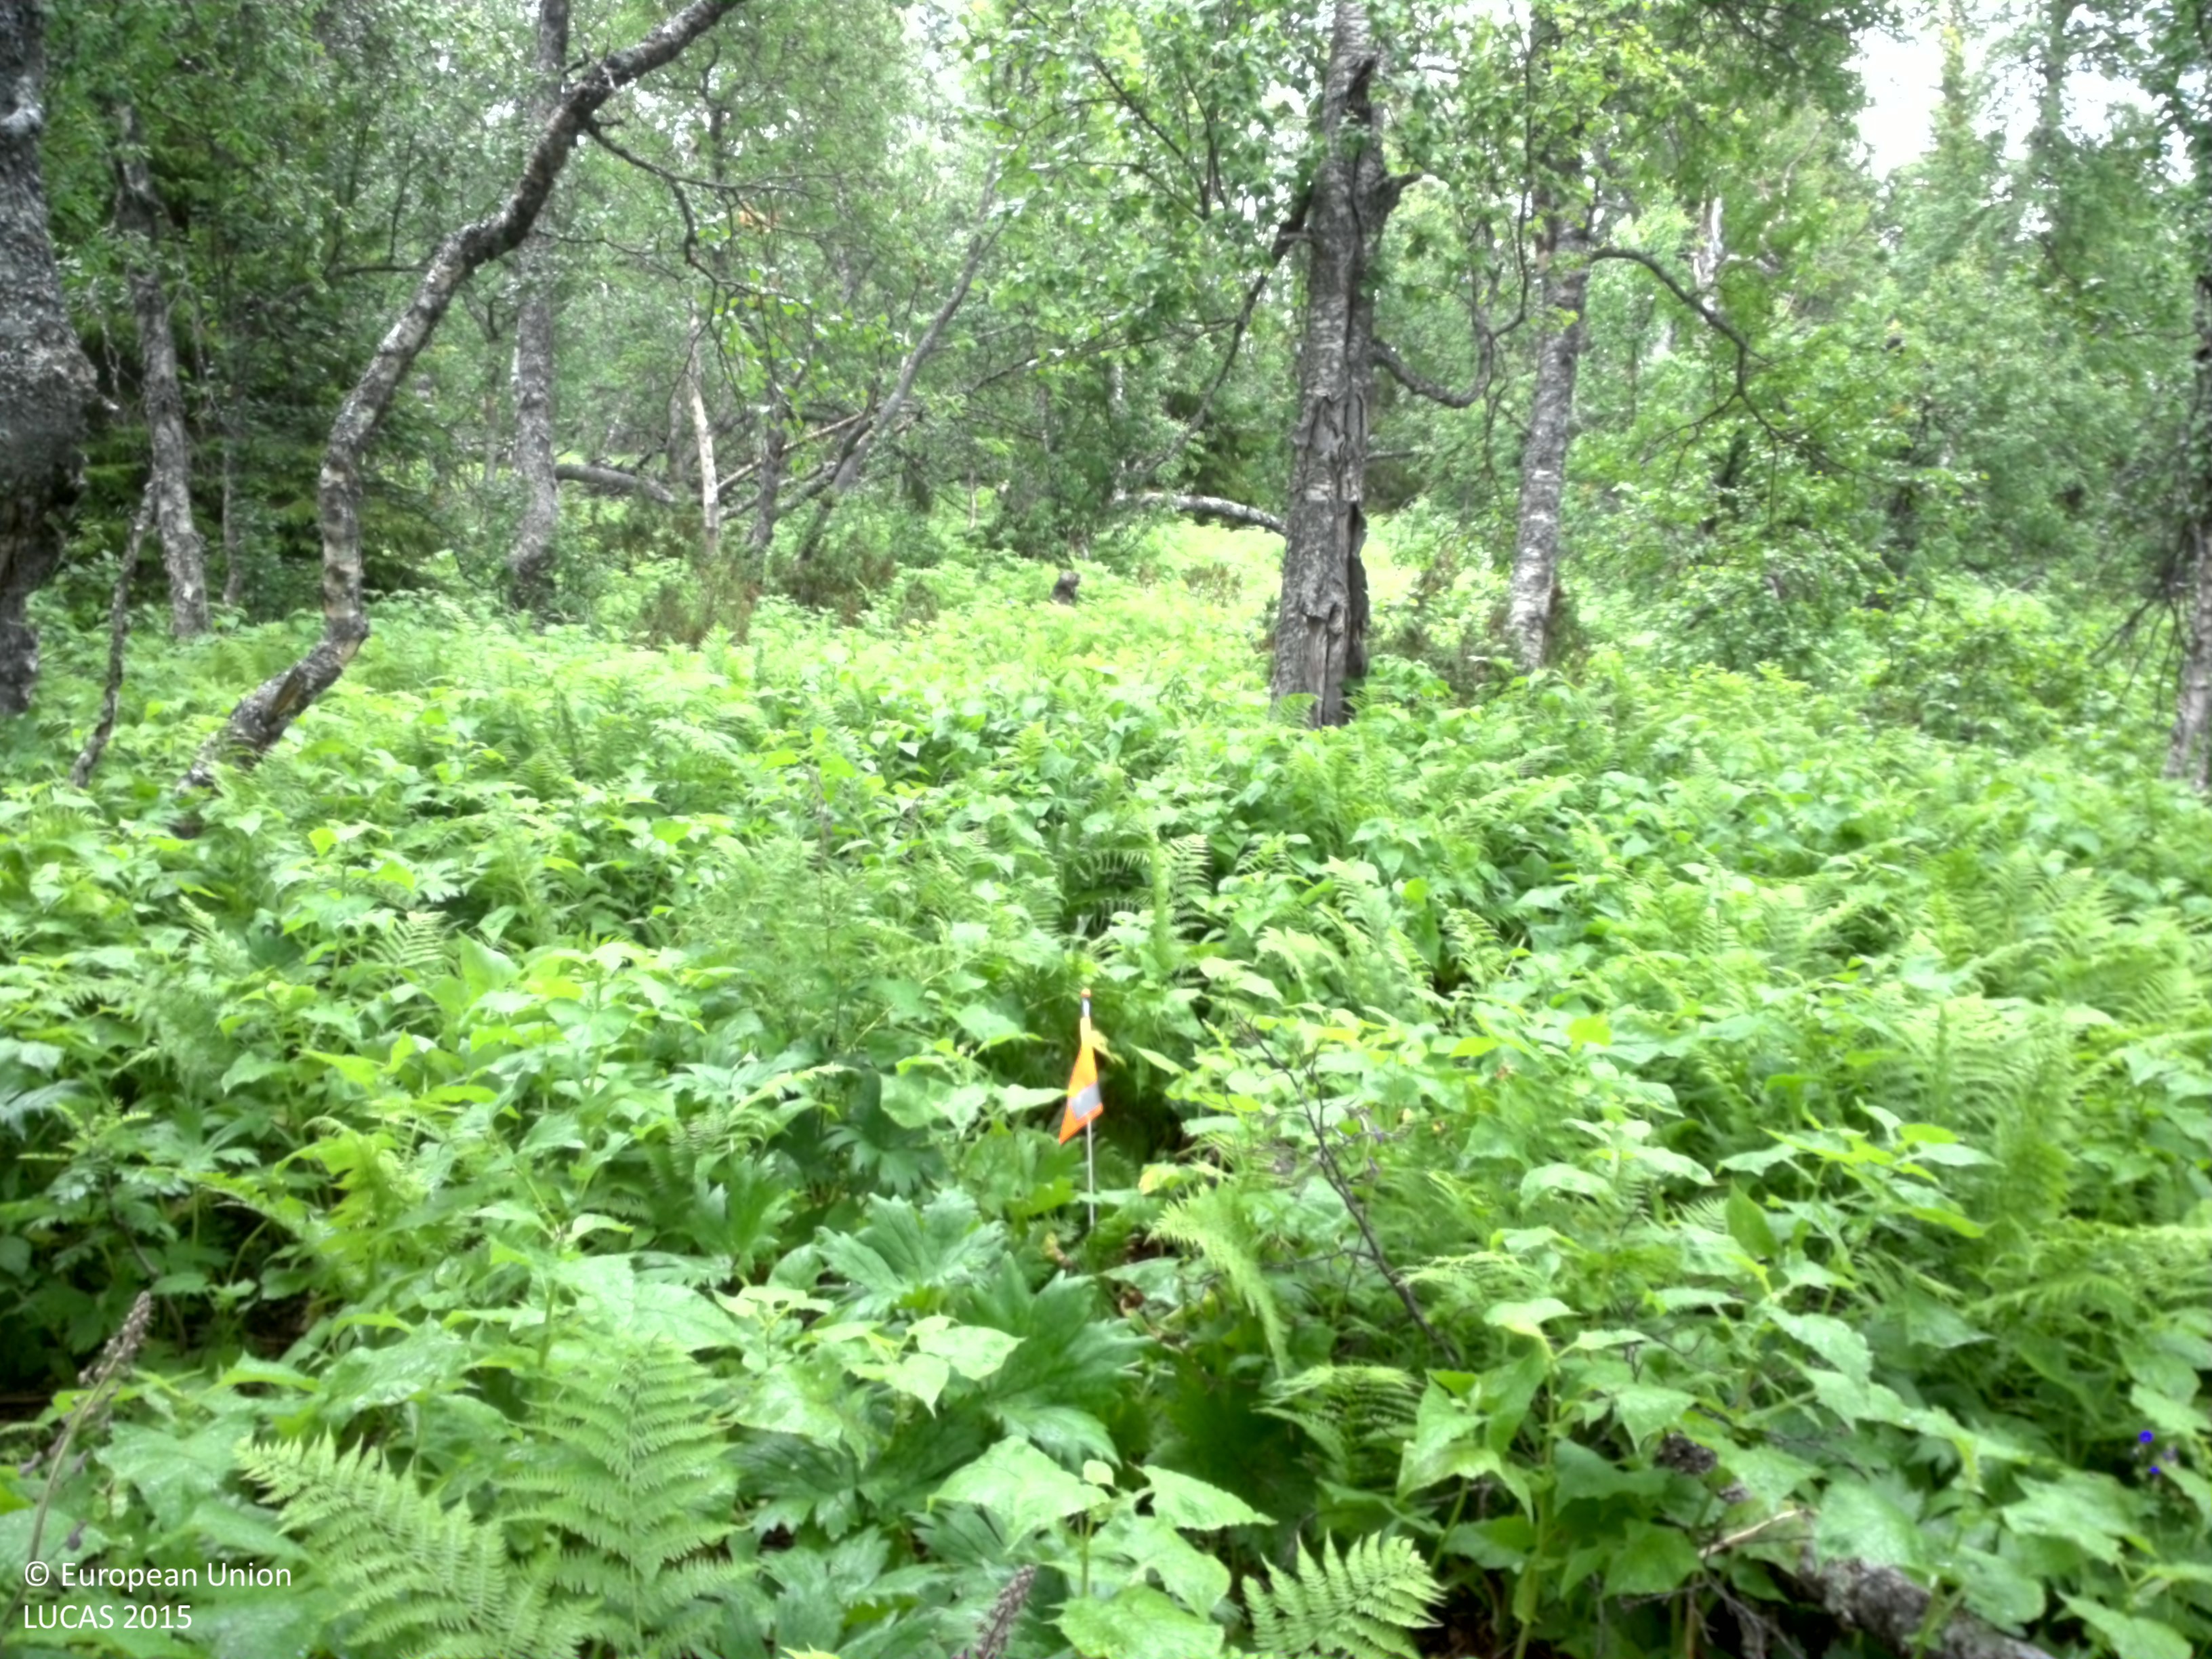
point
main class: Woodland
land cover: Broadleaved woodland
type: non-riverine alder, birch or aspen forest
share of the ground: 25 - 50 %
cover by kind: herbaceous plants 75 %, broadleaved forest trees 25 %
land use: Semi-natural and natural areas not in use
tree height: > 5 m
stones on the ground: 10 - 25 %
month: August
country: SE
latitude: 65.2759
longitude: 15.6438
